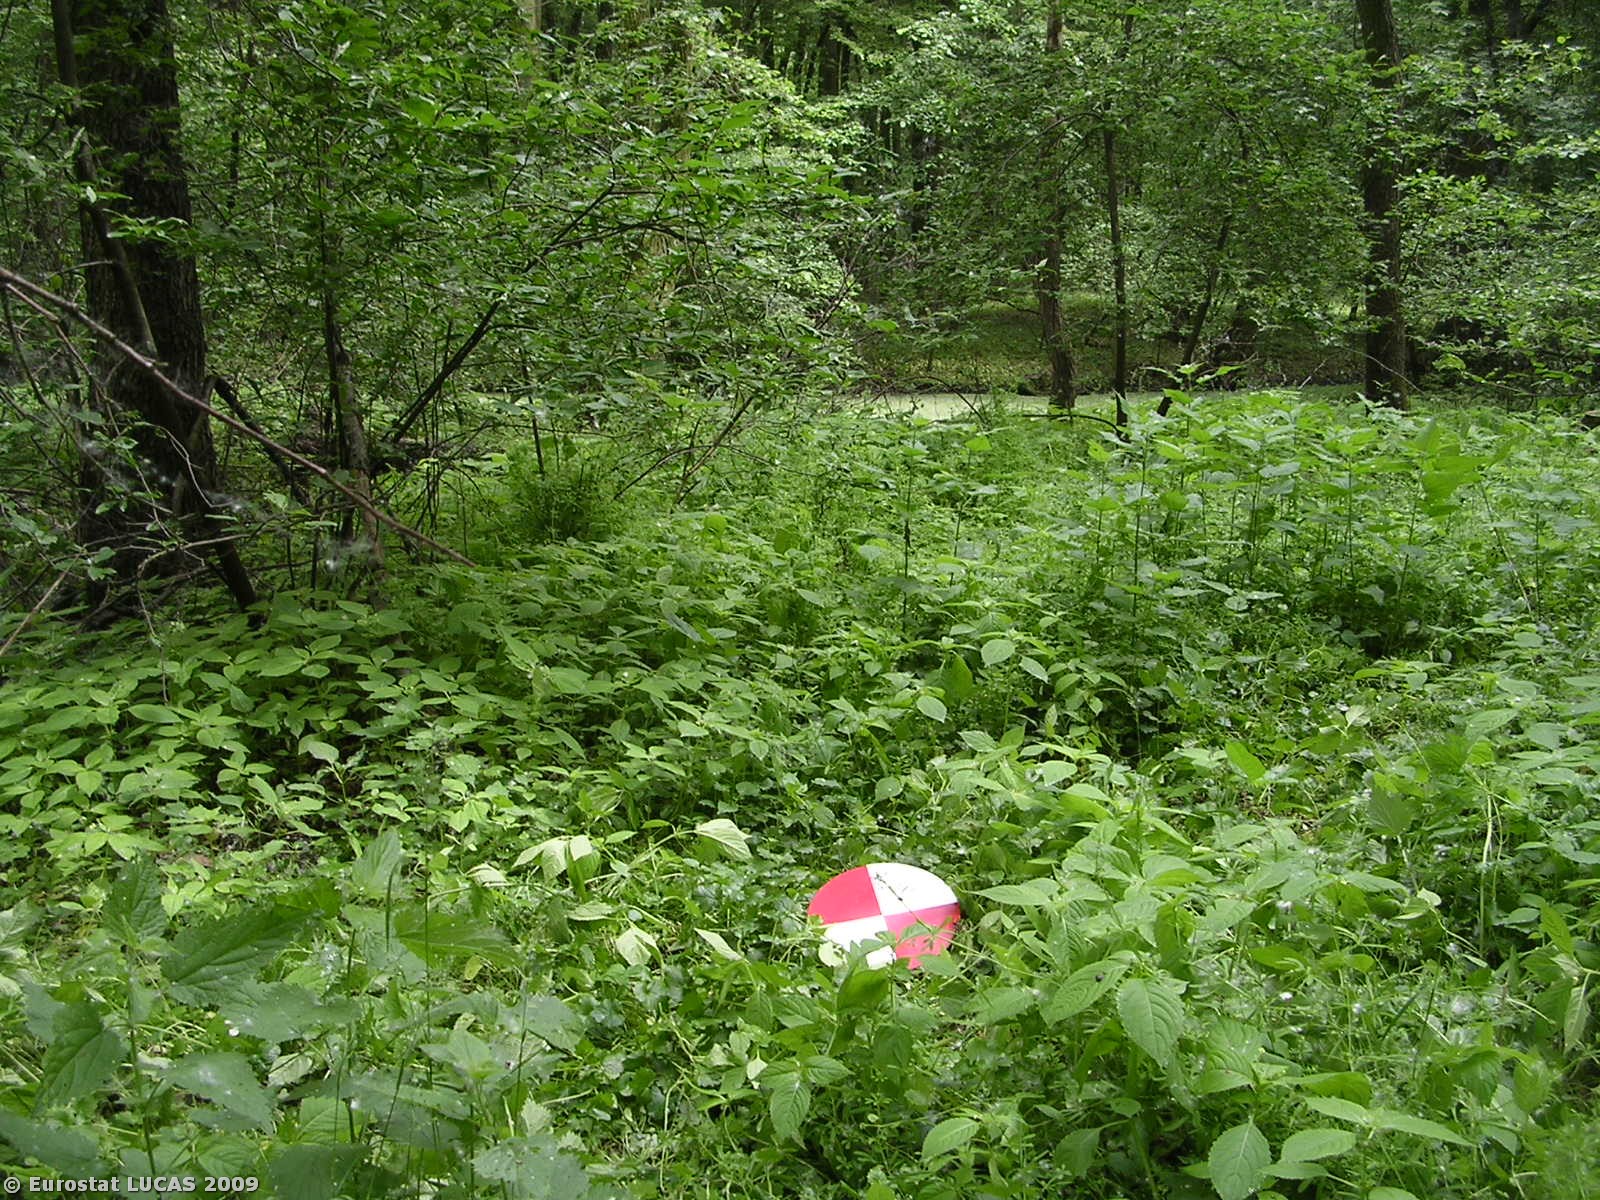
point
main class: Woodland
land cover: Broadleaved woodland
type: floodplain forest
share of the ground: > 75 %
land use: Nature reserves
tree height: > 5 m
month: May
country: CZ
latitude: 50.1707
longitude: 14.8608
